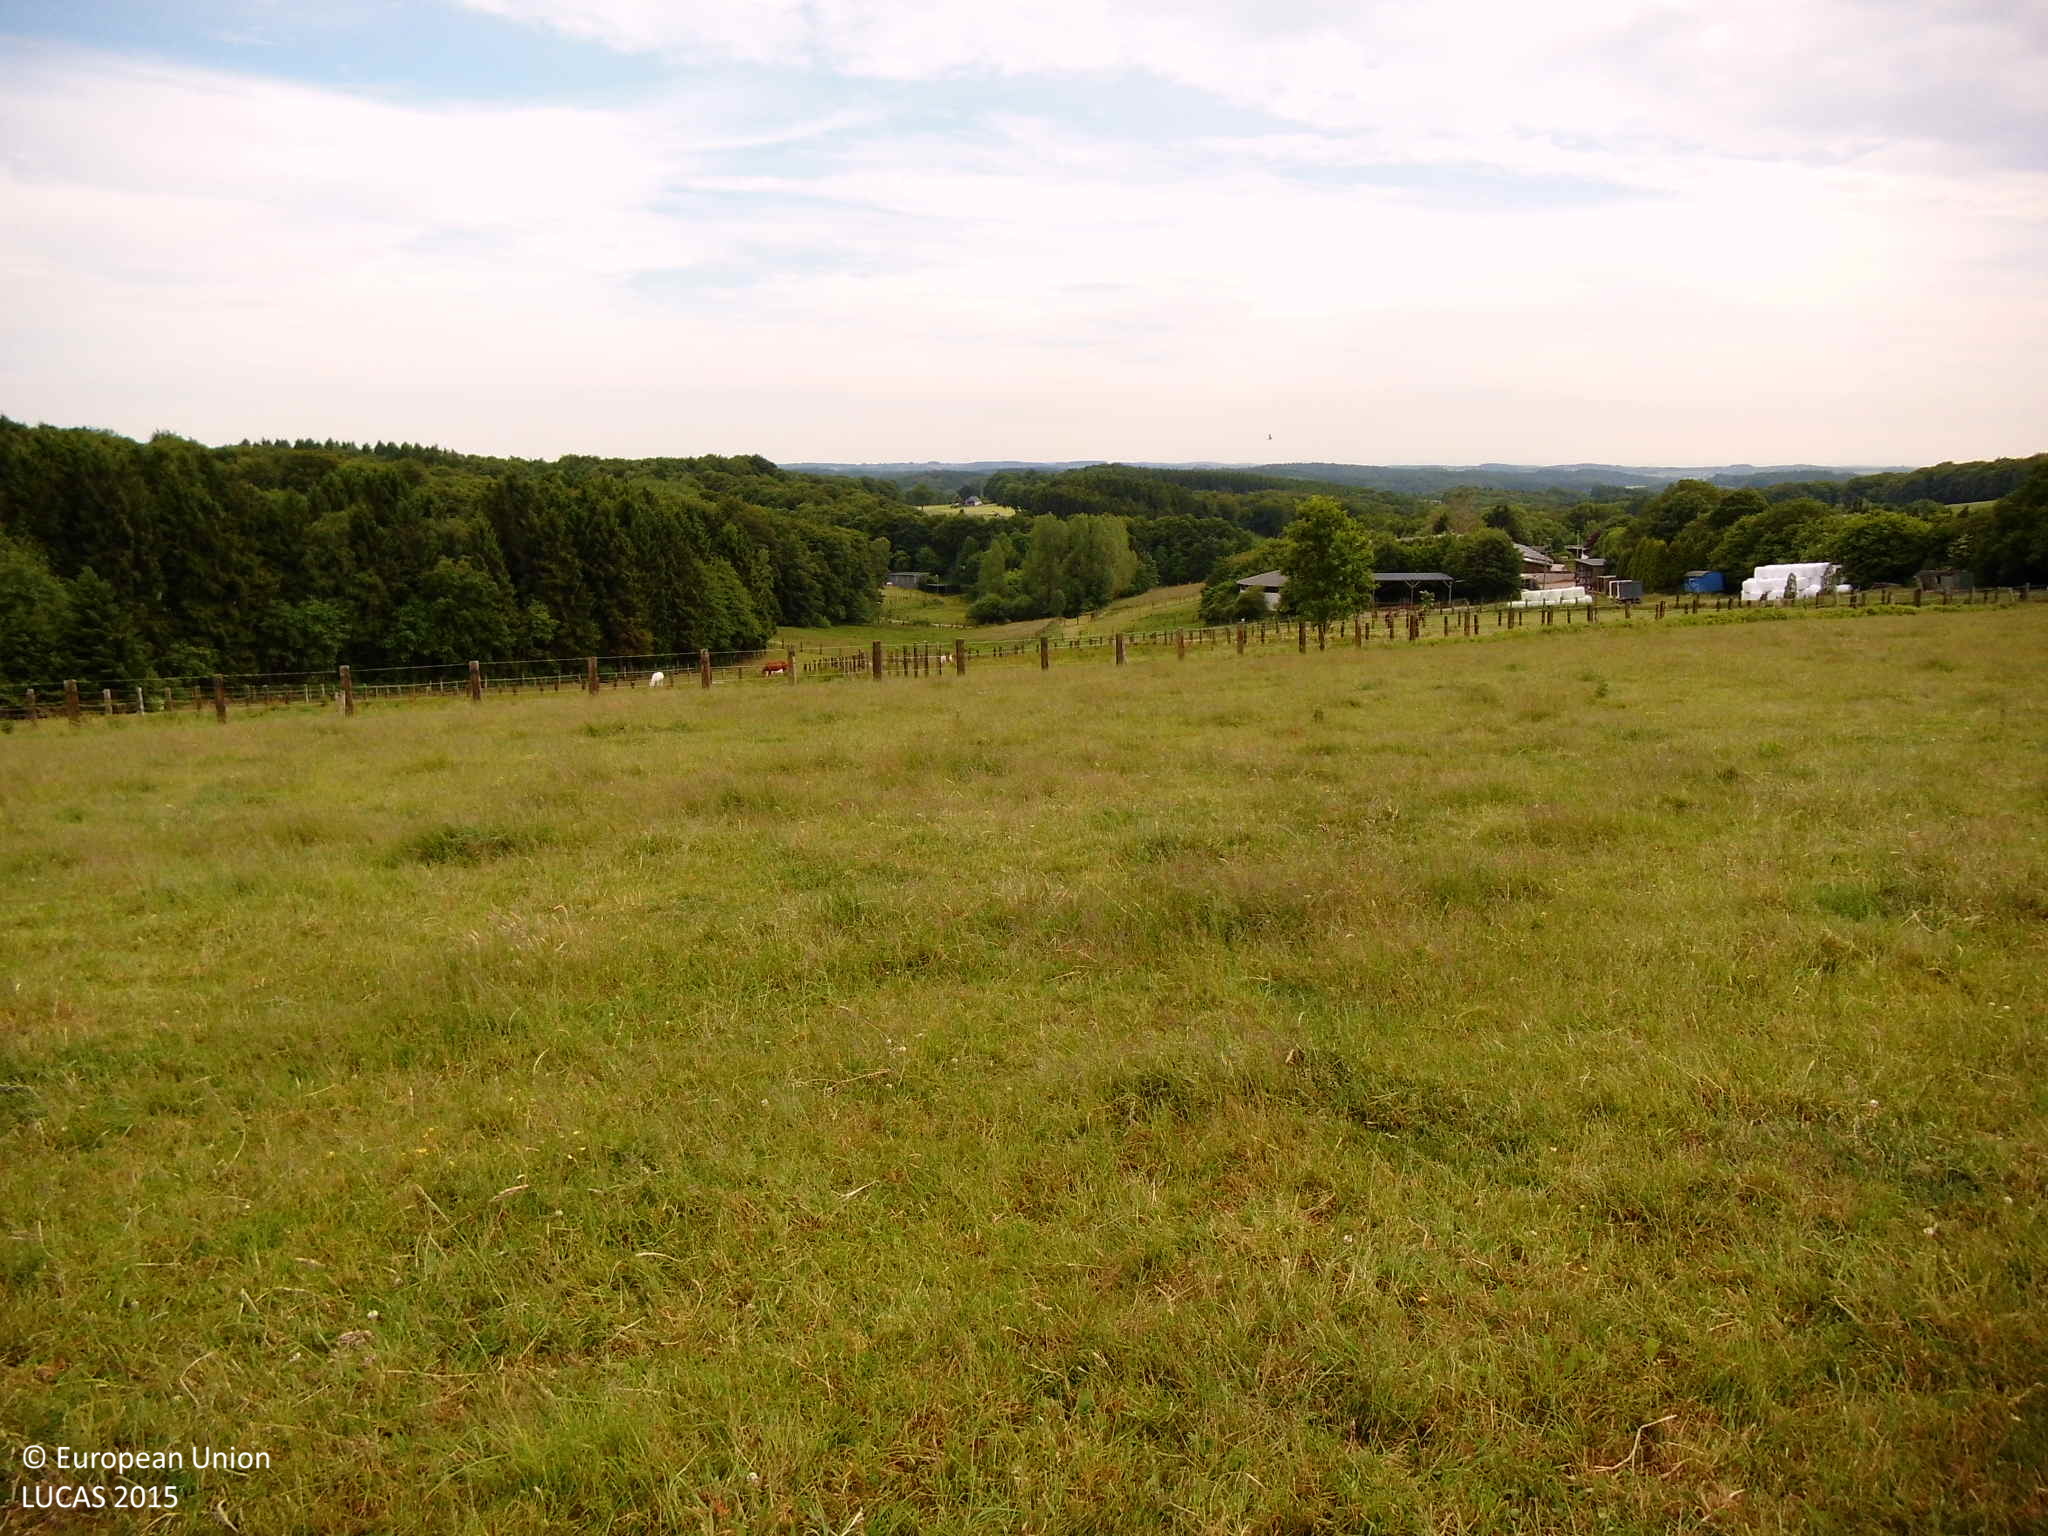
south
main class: Grassland
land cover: Grassland without tree/shrub cover
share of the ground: > 75 %
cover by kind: herbaceous plants 100 %
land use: Agriculture (excluding fallow land and kitchen gardens)
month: June
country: DE
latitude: 51.1982
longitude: 7.4099
